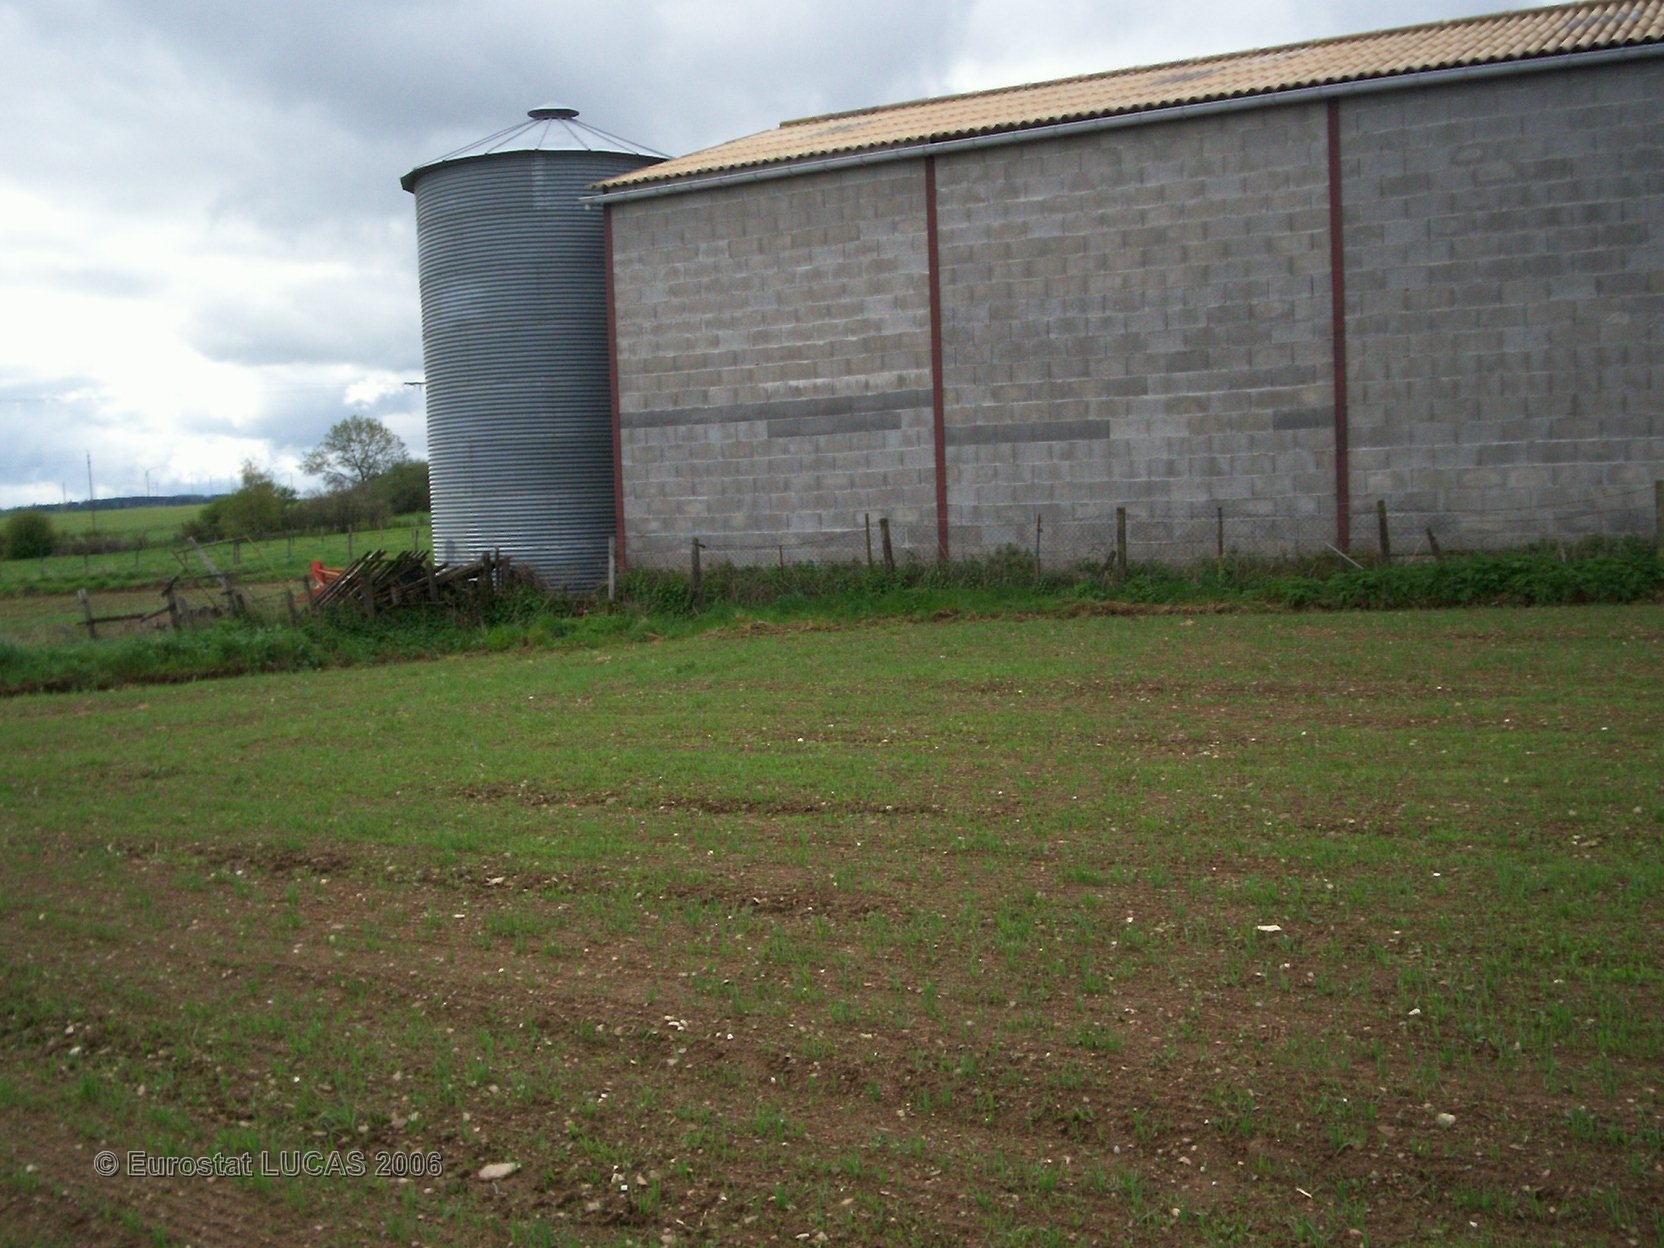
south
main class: Grassland
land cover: Grassland without tree/shrub cover
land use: Agriculture (excluding fallow land and kitchen gardens)
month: May
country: FR
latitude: 45.1795
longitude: 3.2449
